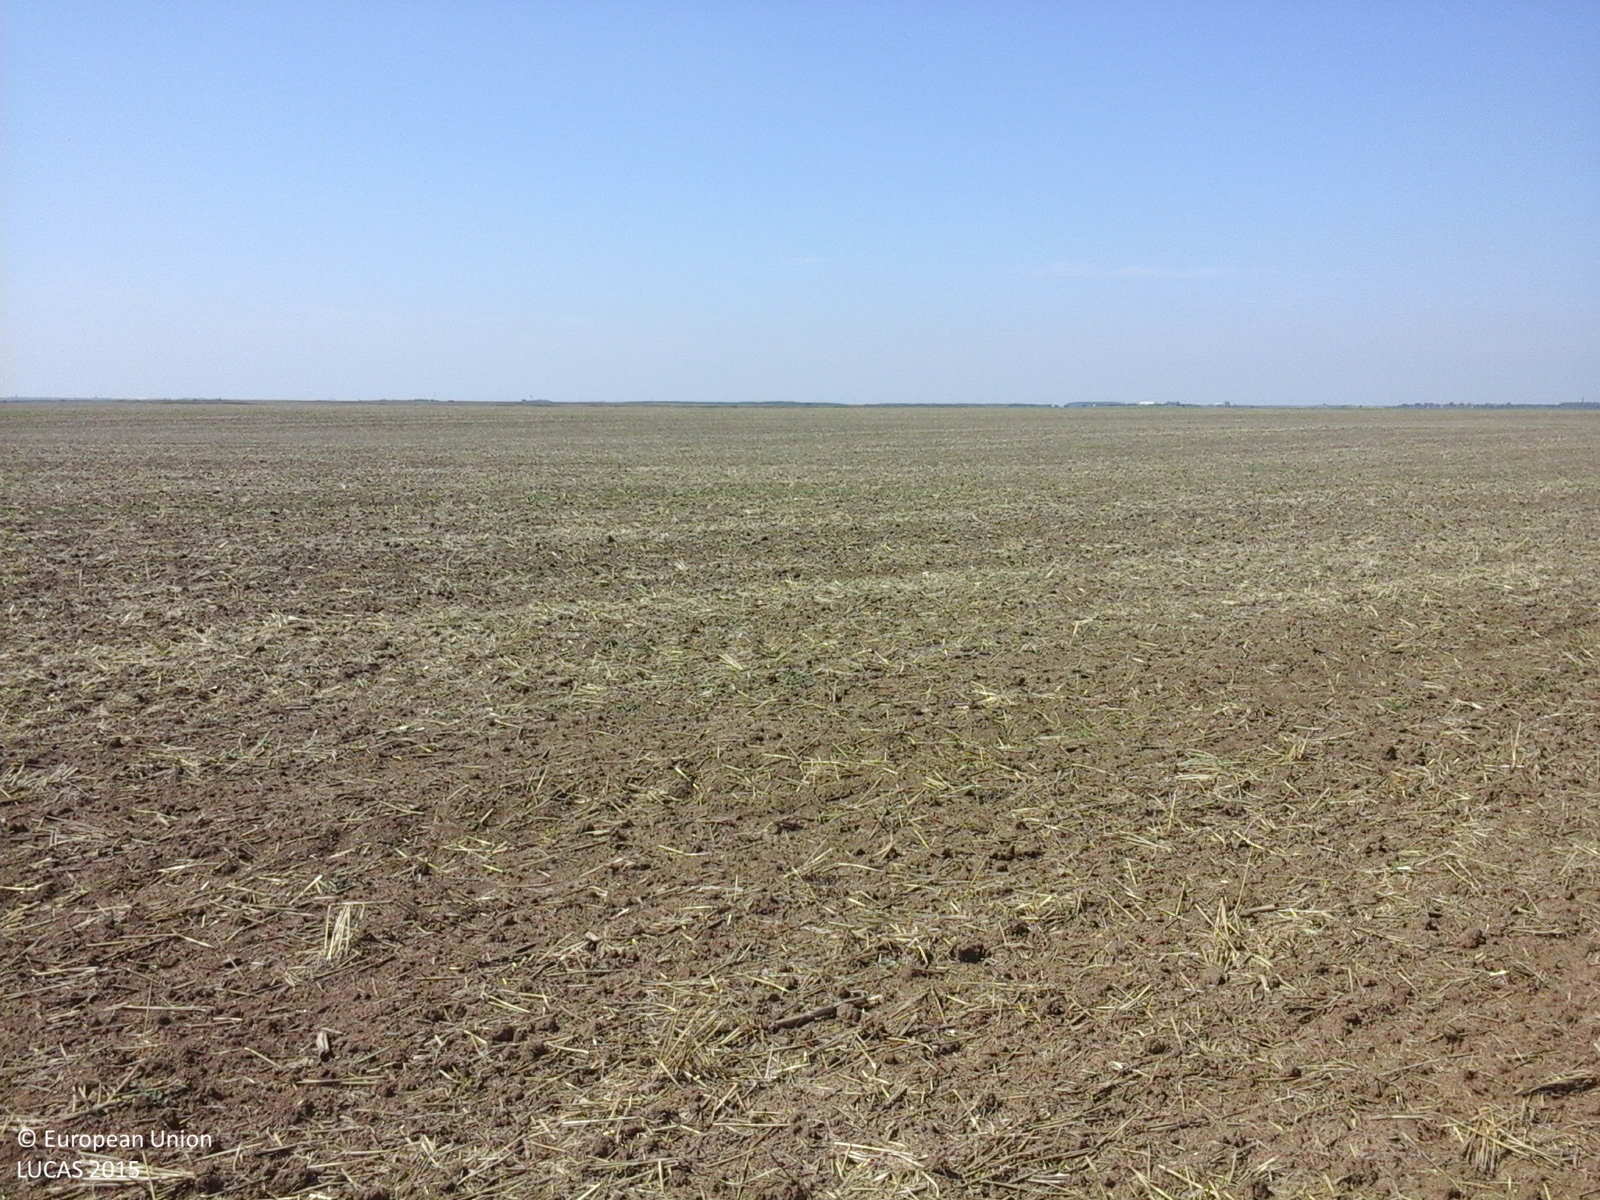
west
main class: Cropland
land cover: Common wheat
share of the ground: 25 - 50 %
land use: Agriculture (excluding fallow land and kitchen gardens)
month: August
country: RO
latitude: 45.8933
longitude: 21.1525
